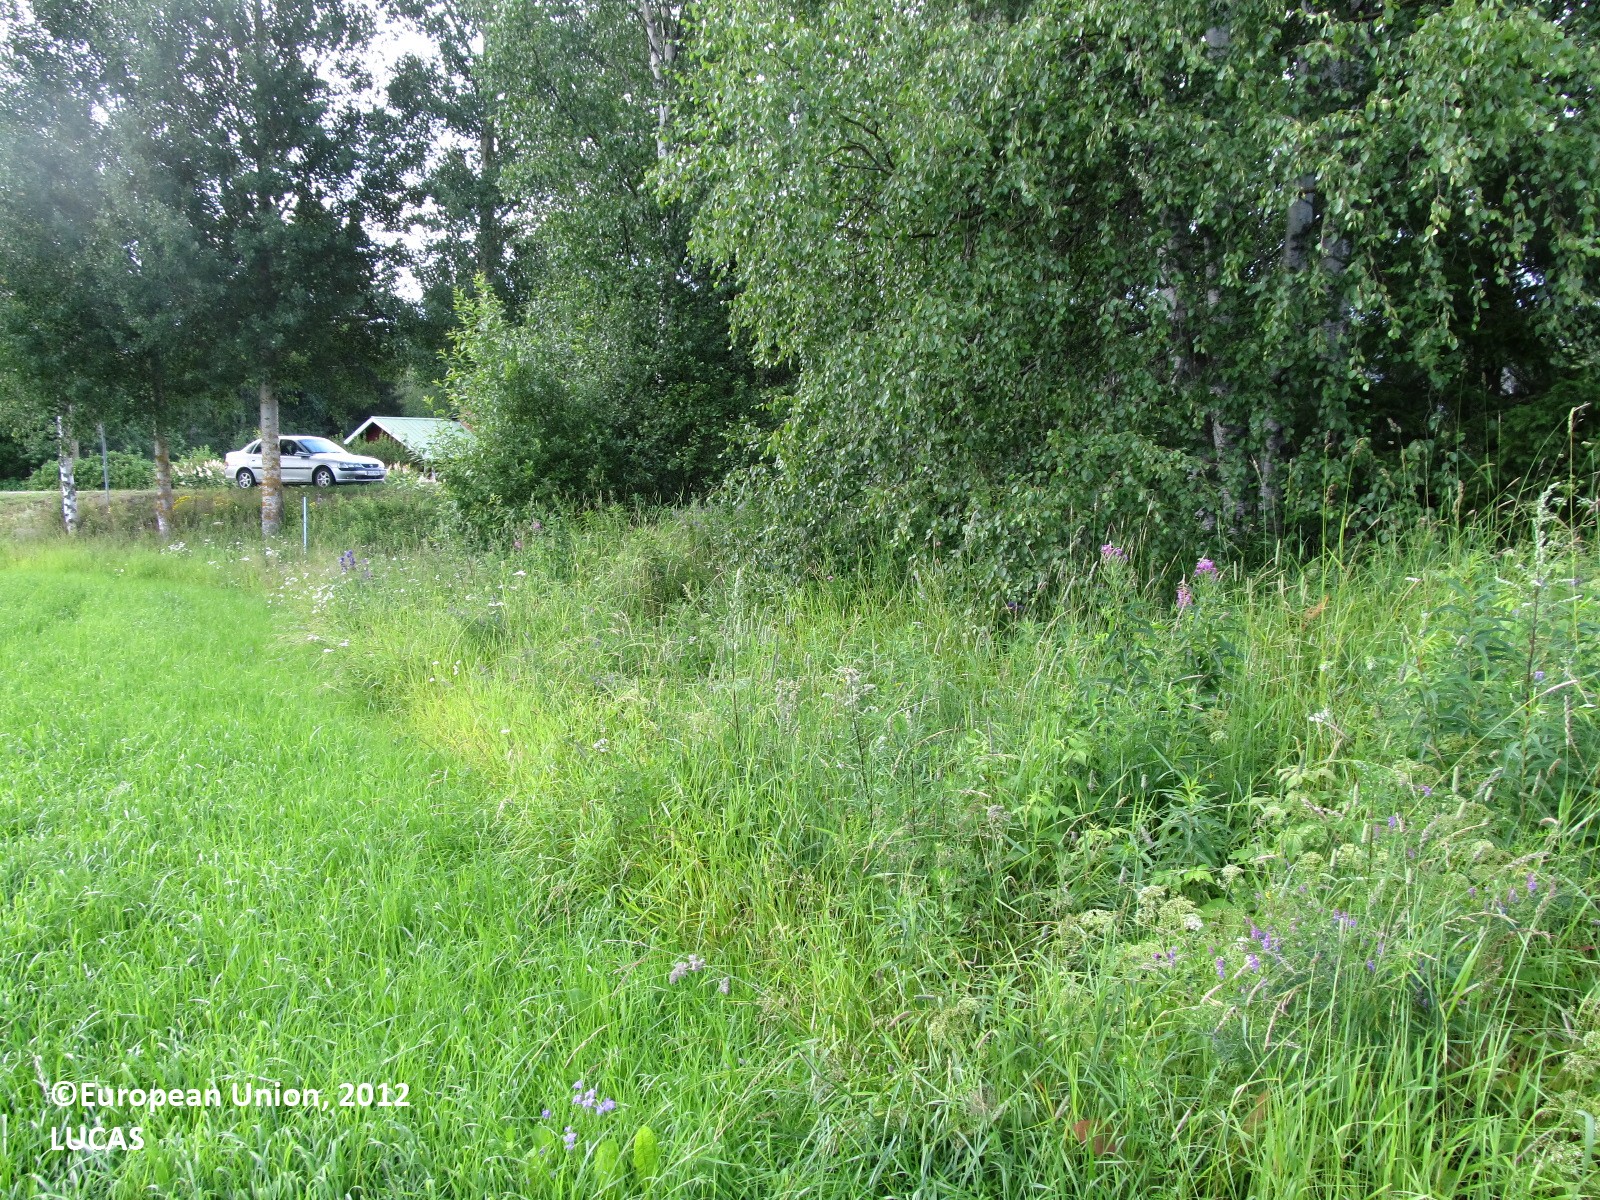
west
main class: Cropland
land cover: Temporary grasslands
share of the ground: > 75 %
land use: Agriculture (excluding fallow land and kitchen gardens)
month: July
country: FI
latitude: 62.0154
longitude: 28.2900
